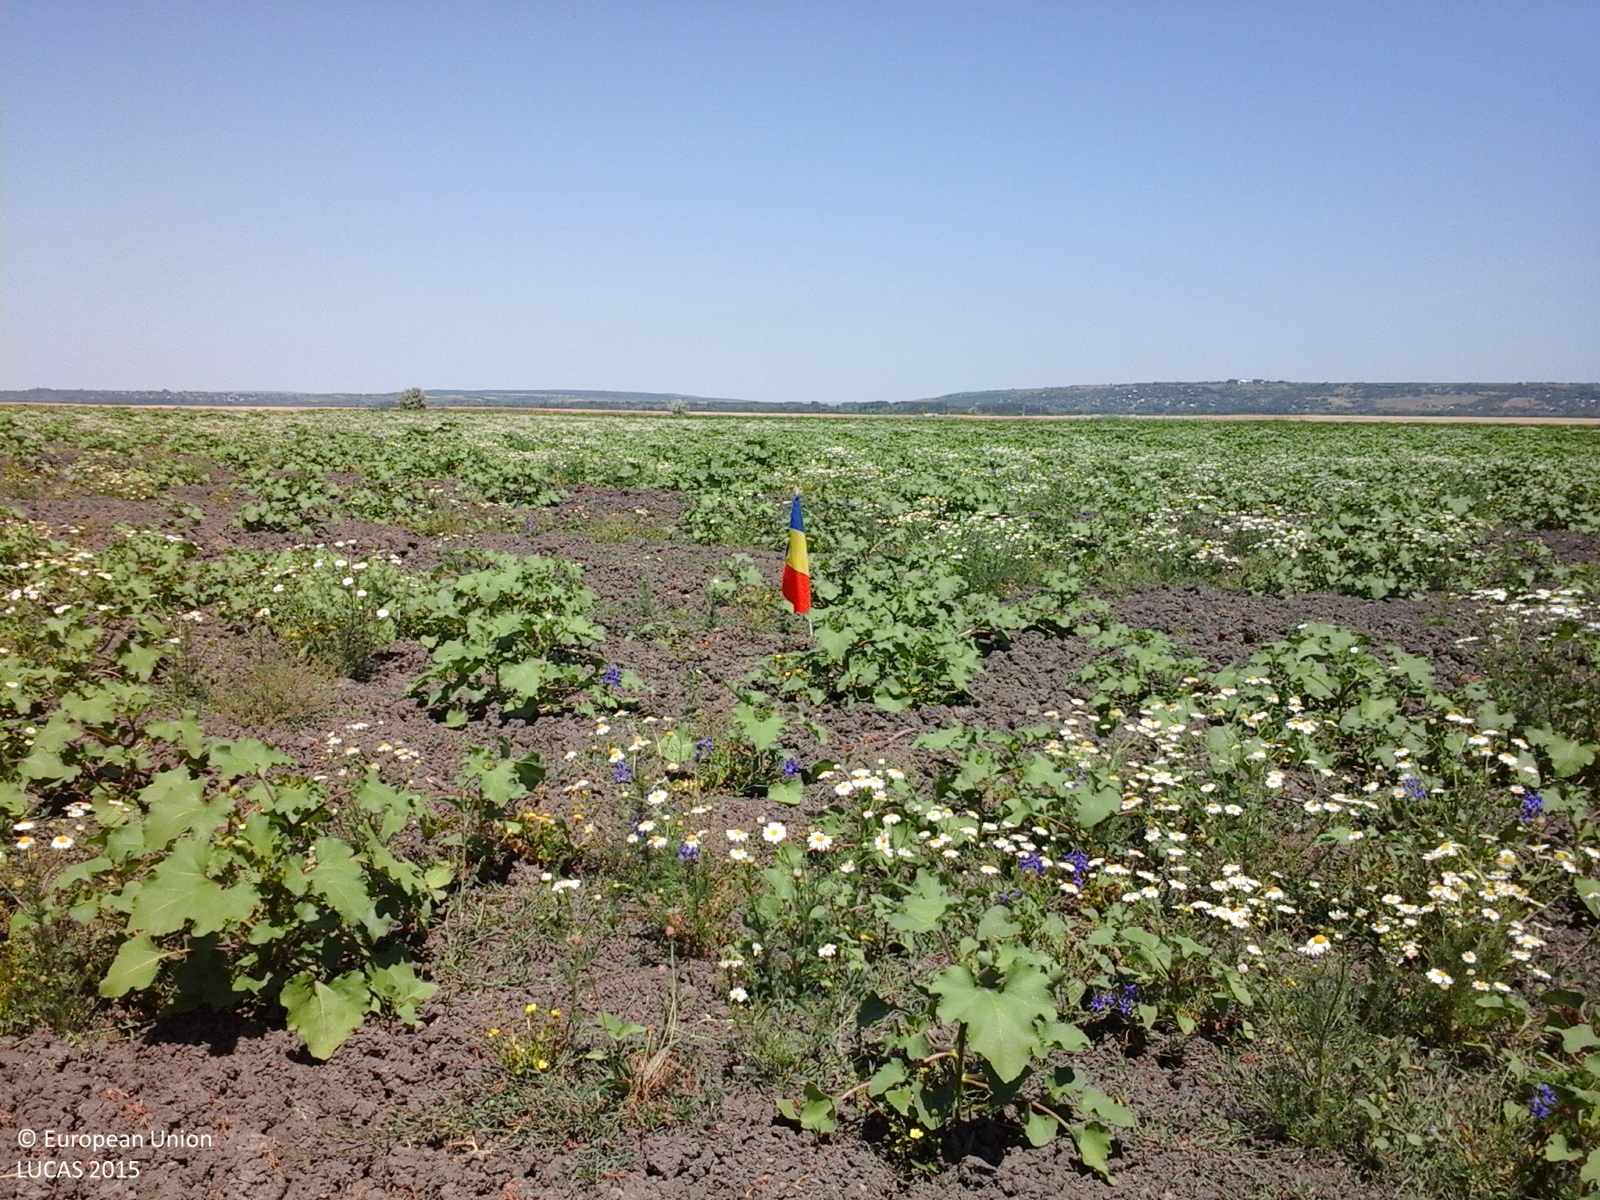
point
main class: Cropland
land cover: Other fresh vegetables
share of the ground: 50 - 75 %
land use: Agriculture (excluding fallow land and kitchen gardens)
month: June
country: RO
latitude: 47.0098
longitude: 27.9520
